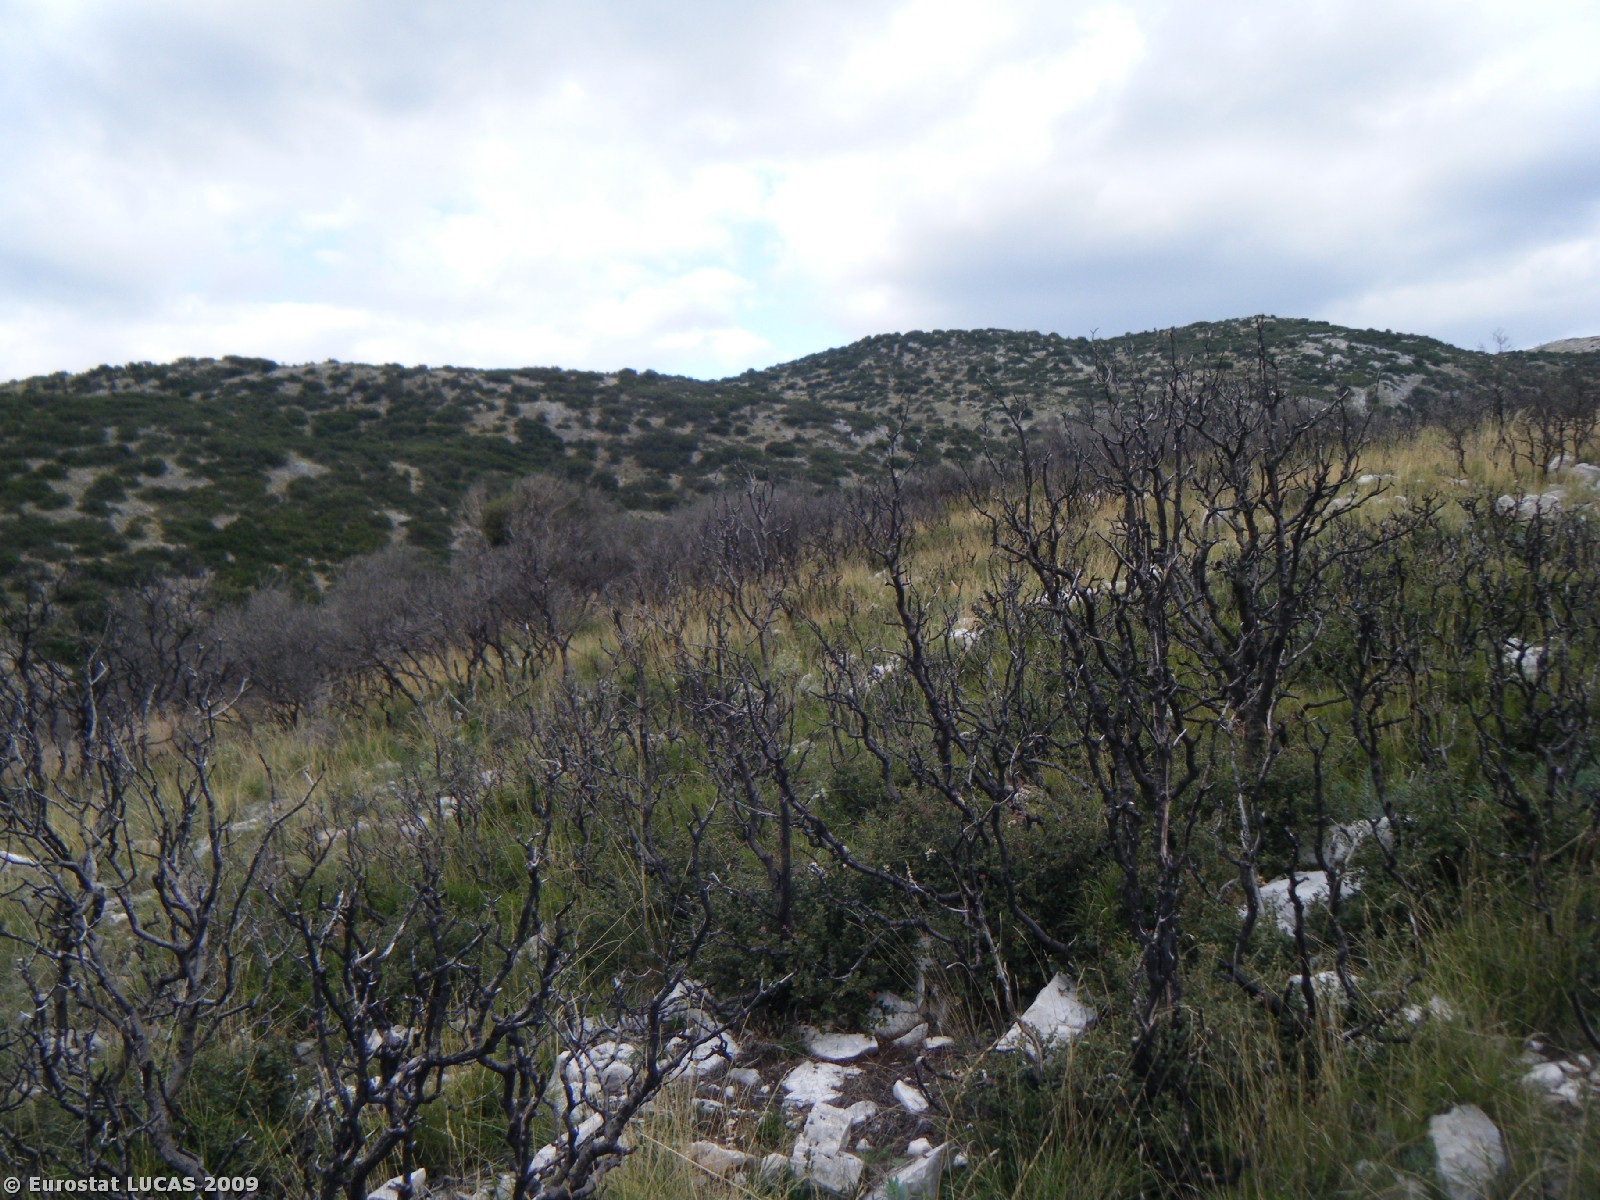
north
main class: Grassland
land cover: Grassland with sparse tree/shrub cover
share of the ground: 50 - 75 %
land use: Unused
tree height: < 5 m
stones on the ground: 25 - 50 %
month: October
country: GR
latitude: 37.4682
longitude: 22.2281
